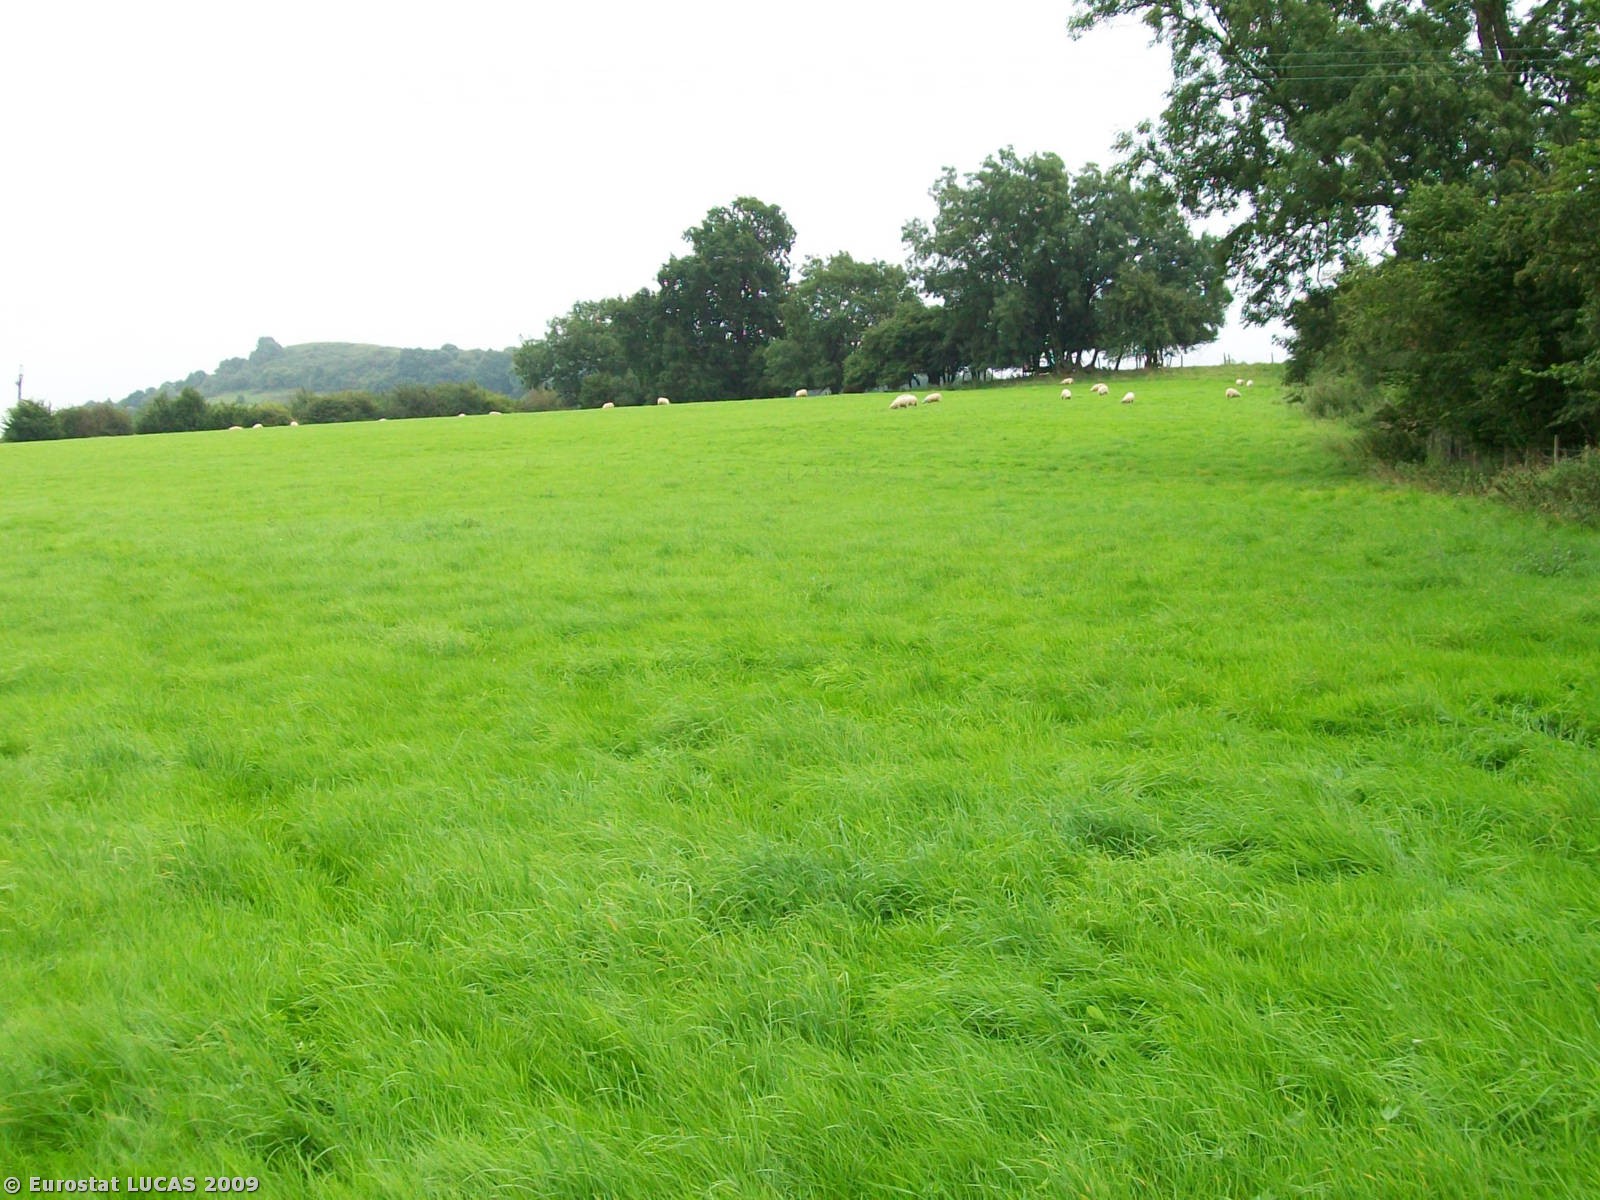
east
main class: Grassland
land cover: Grassland without tree/shrub cover
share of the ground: > 75 %
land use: Agriculture (excluding fallow land and kitchen gardens)
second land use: Community services
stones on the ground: < 10 %
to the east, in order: Grassland without tree/shrub cover; Fences; Abandoned hedges; Grassland without tree/shrub cover
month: August
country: GB
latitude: 51.6935
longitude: -2.3464
